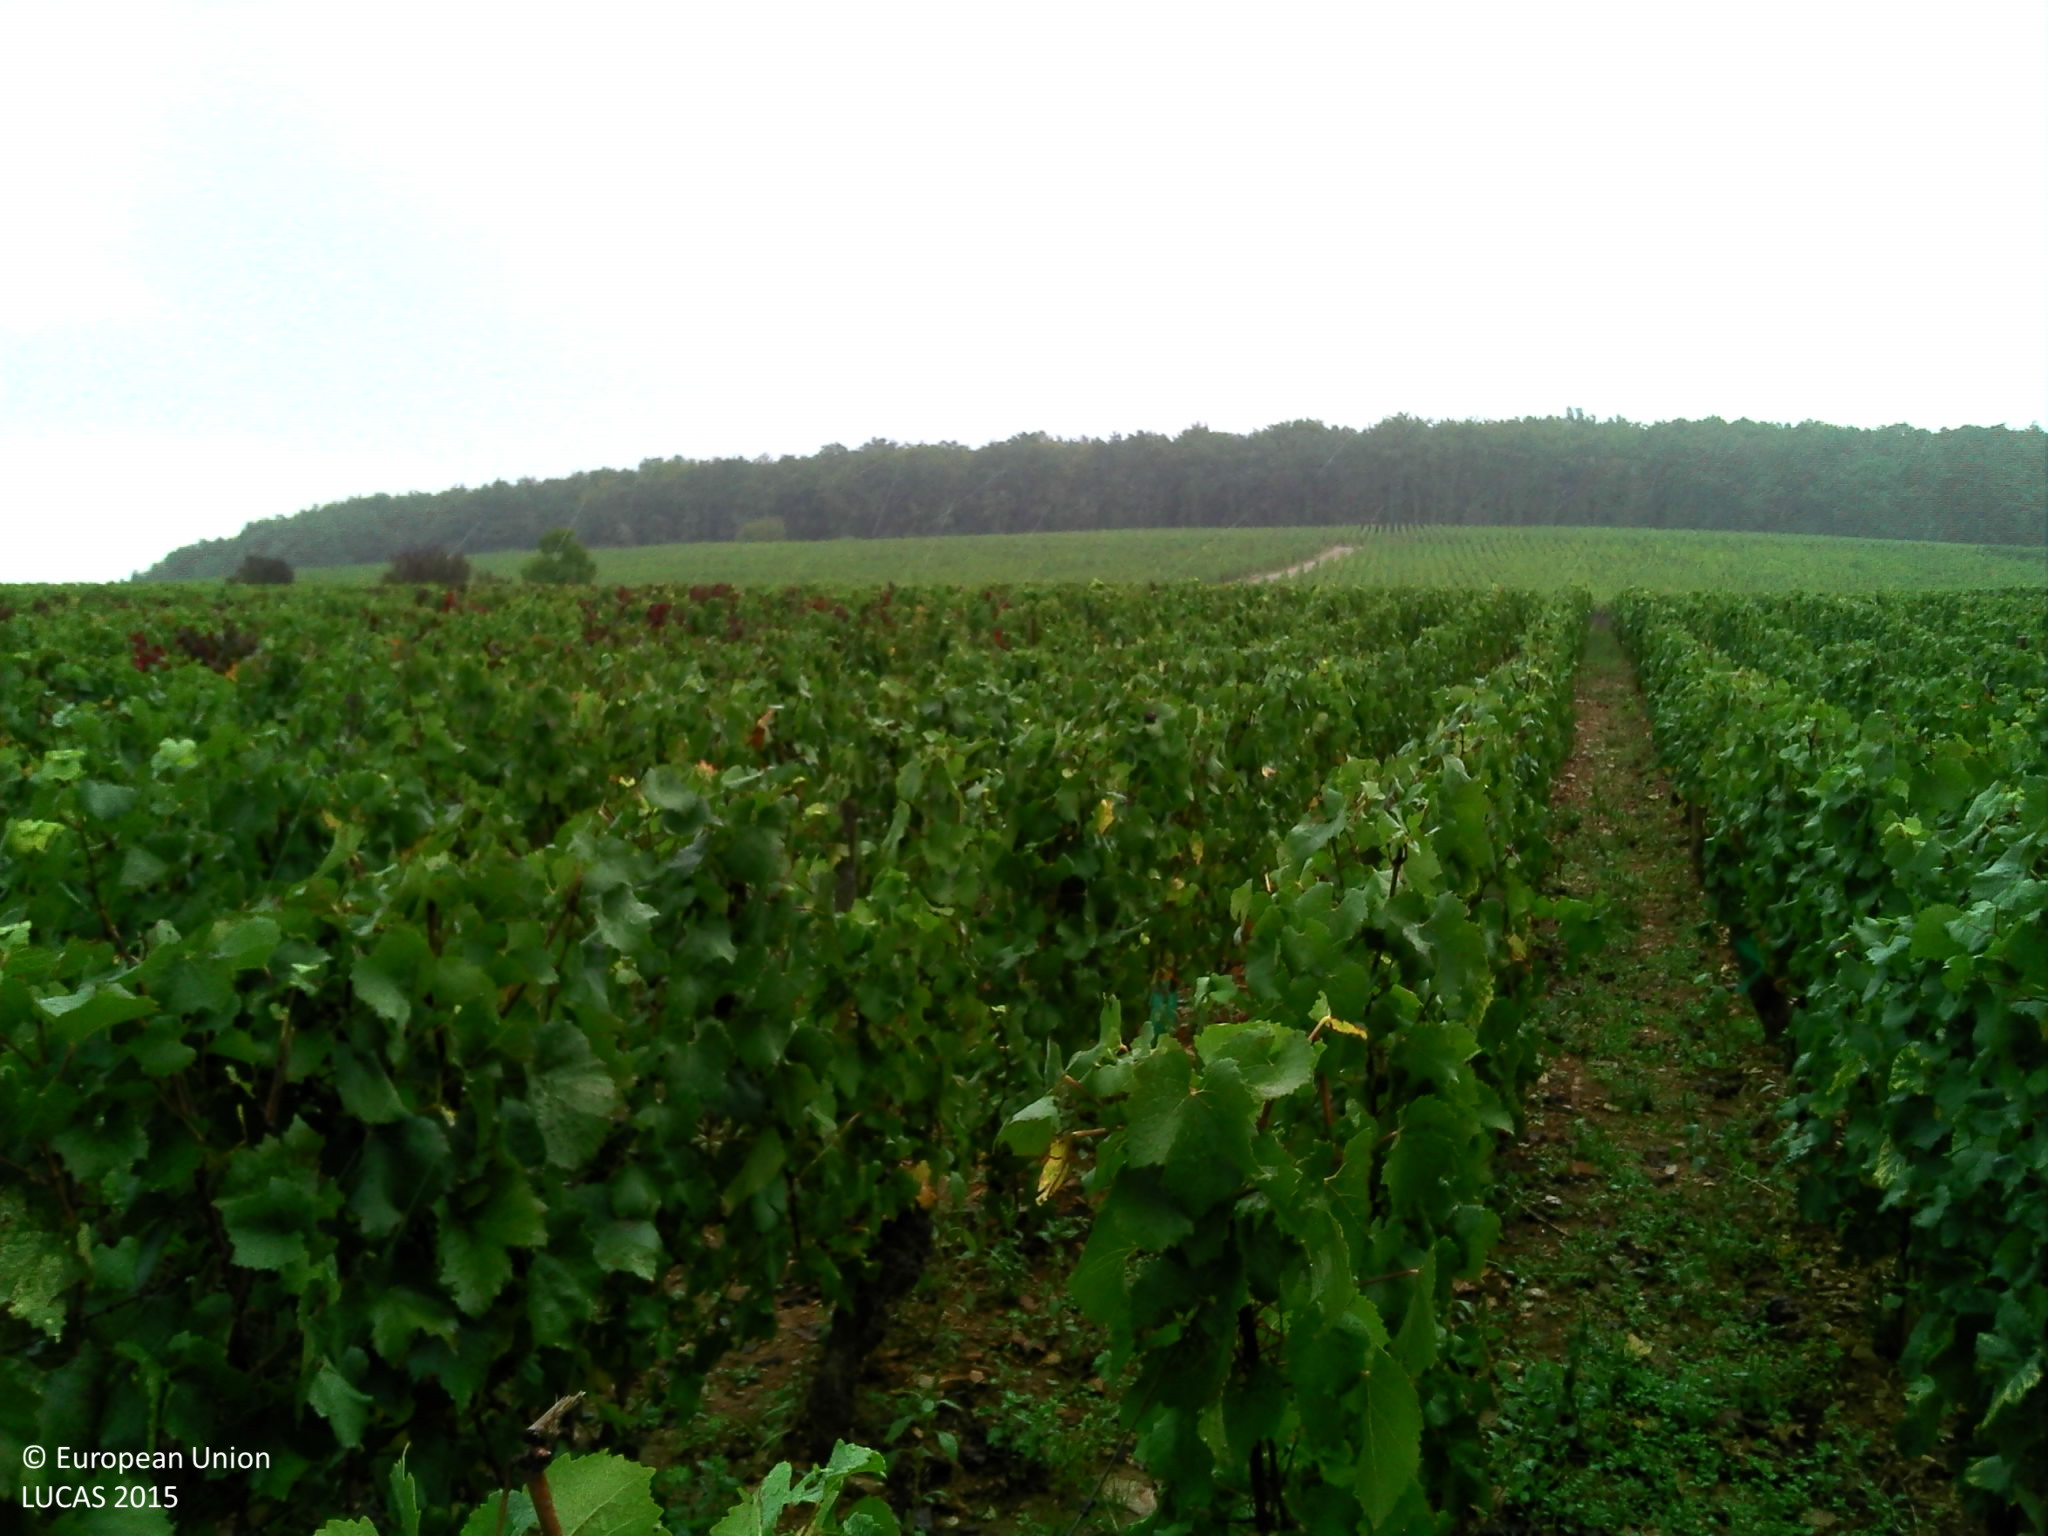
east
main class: Cropland
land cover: Vineyards
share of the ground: 10 - 25 %
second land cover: Other bare soil
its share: > 75 %
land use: Agriculture (excluding fallow land and kitchen gardens)
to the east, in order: Vineyards; Other bare soil; Tracks; Vineyards; Tracks; Vineyards; Paved roads, cycling and walking lanes; Vineyards; Tracks; Vineyards
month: September
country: FR
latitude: 47.0753
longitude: 4.8514
